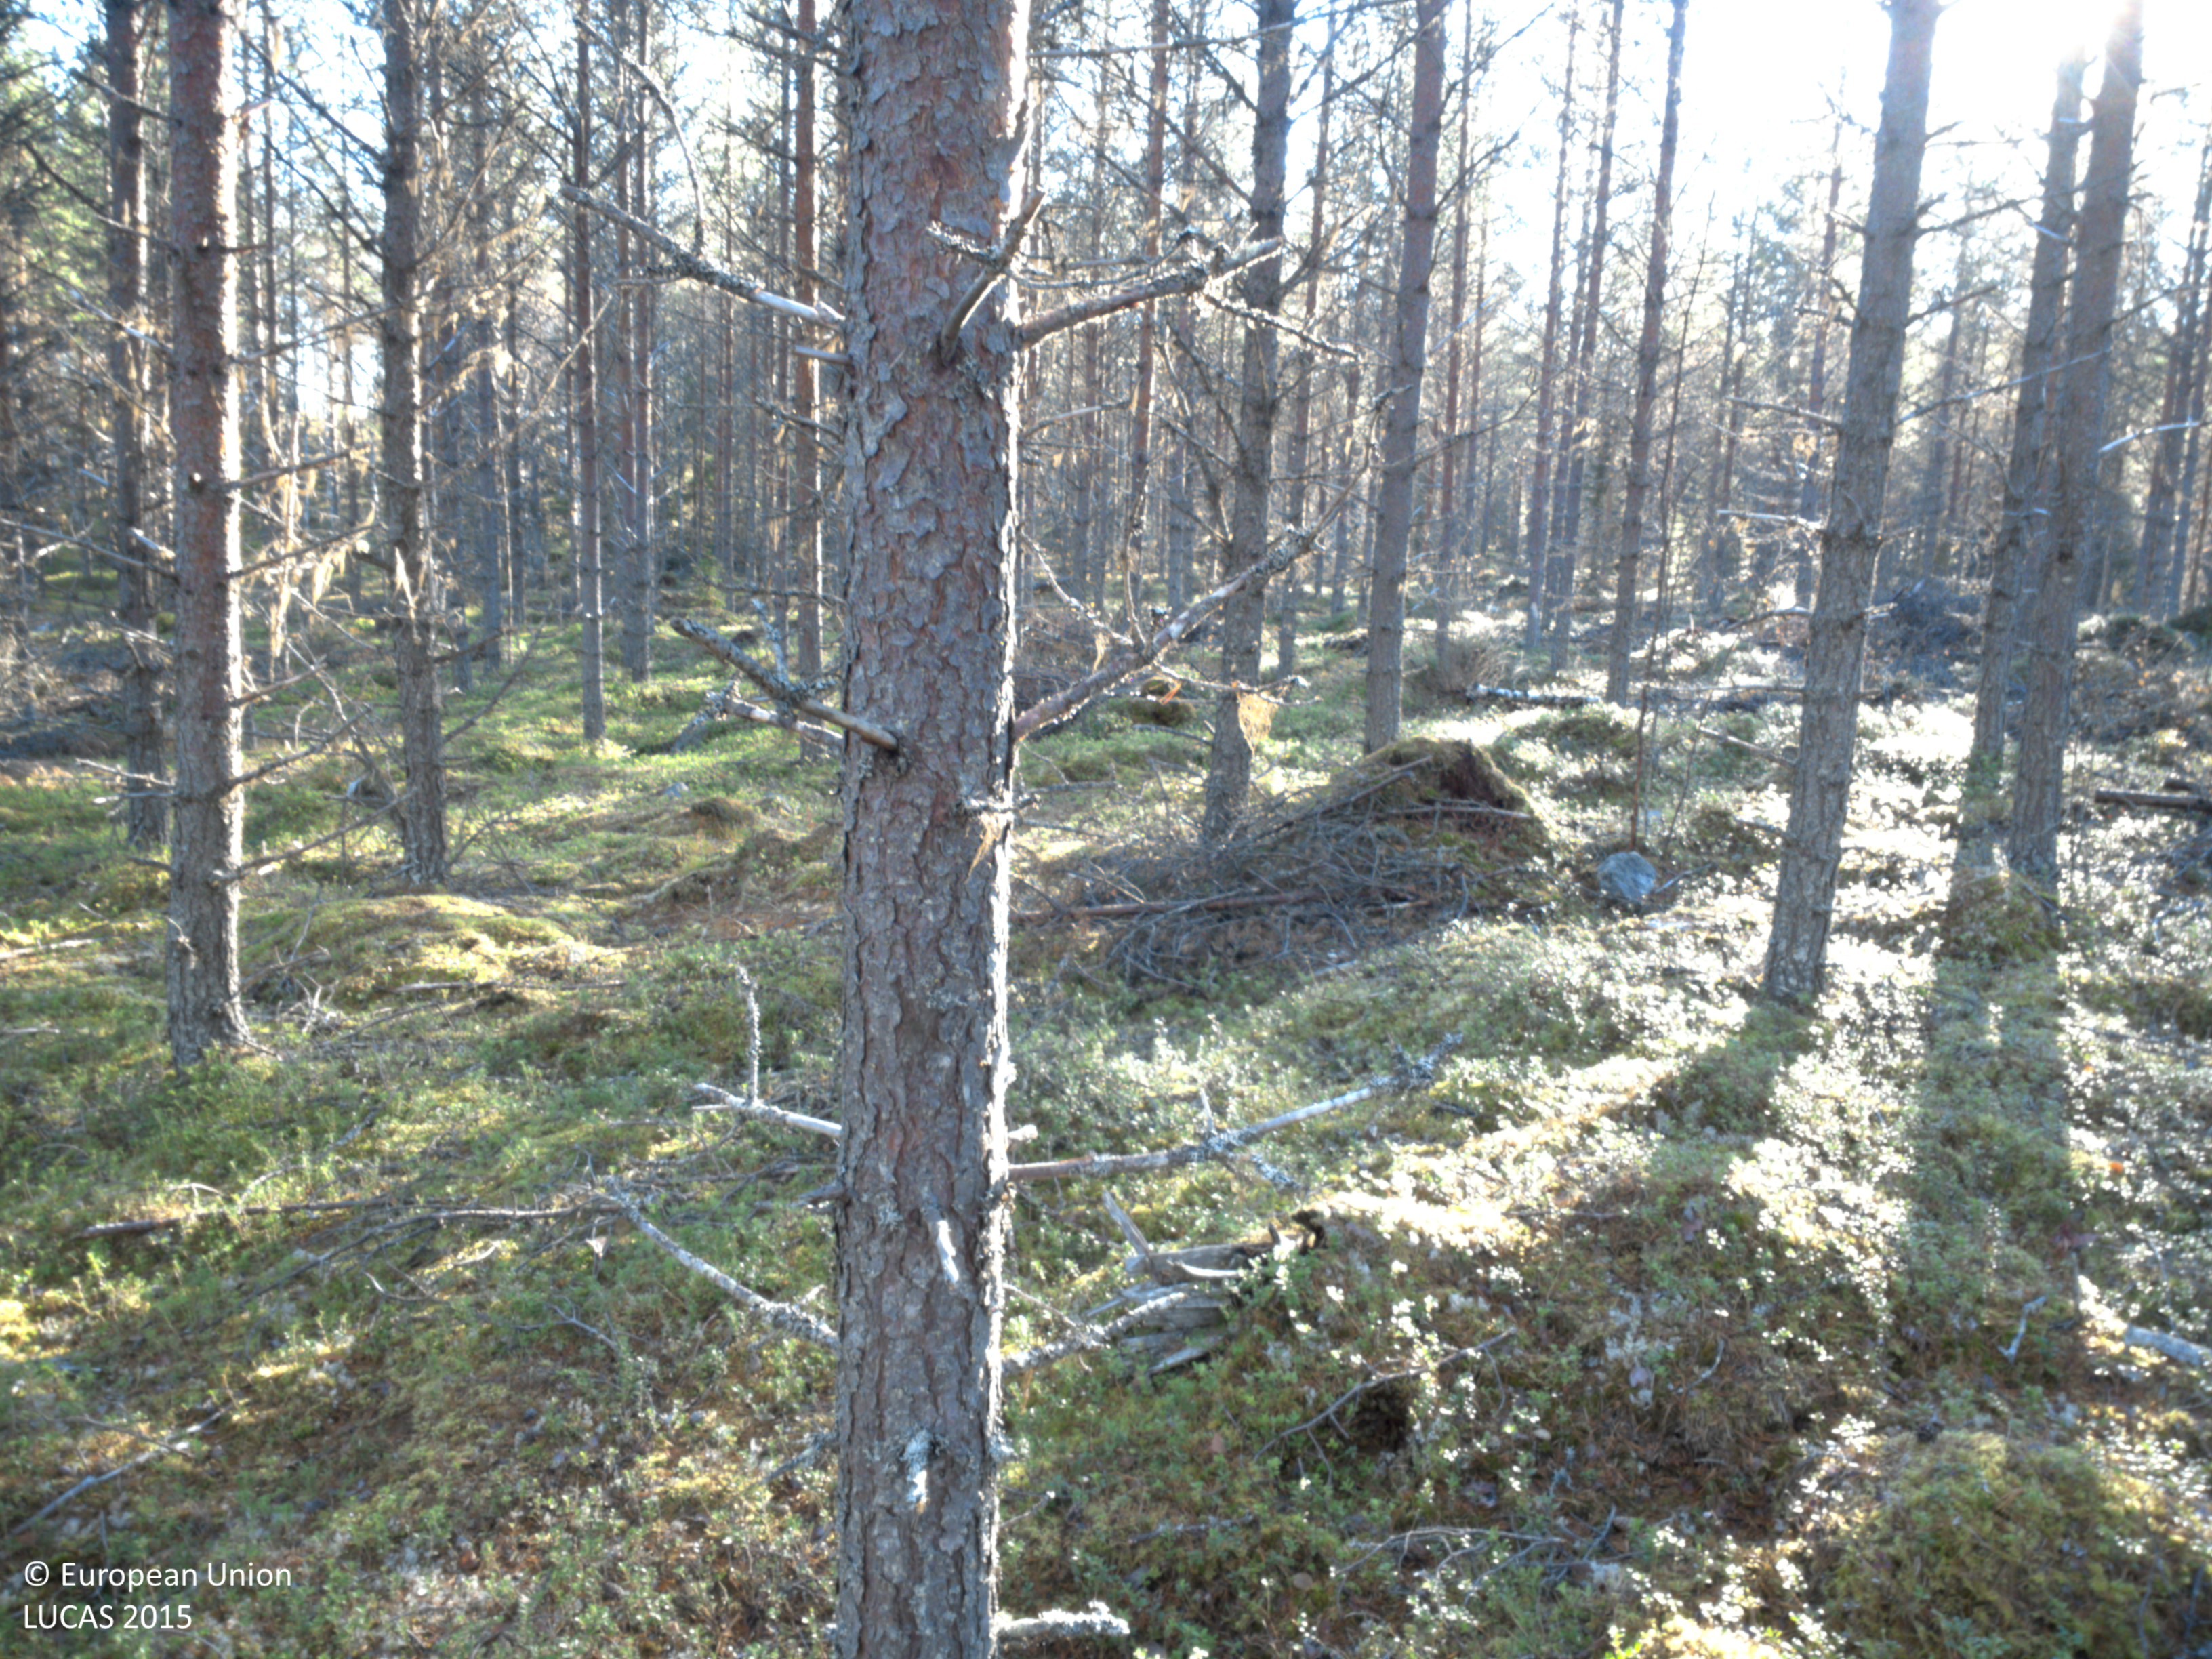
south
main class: Woodland
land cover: Pine dominated coniferous woodland
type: boreal forest
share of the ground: > 75 %
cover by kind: coniferous forest trees 80 %, shrubs 10 %, herbaceous plants 5 %, lichens and mosses 5 %
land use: Forestry
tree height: > 5 m
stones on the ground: 25 - 50 %
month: October
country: SE
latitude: 64.1247
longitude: 18.3296
